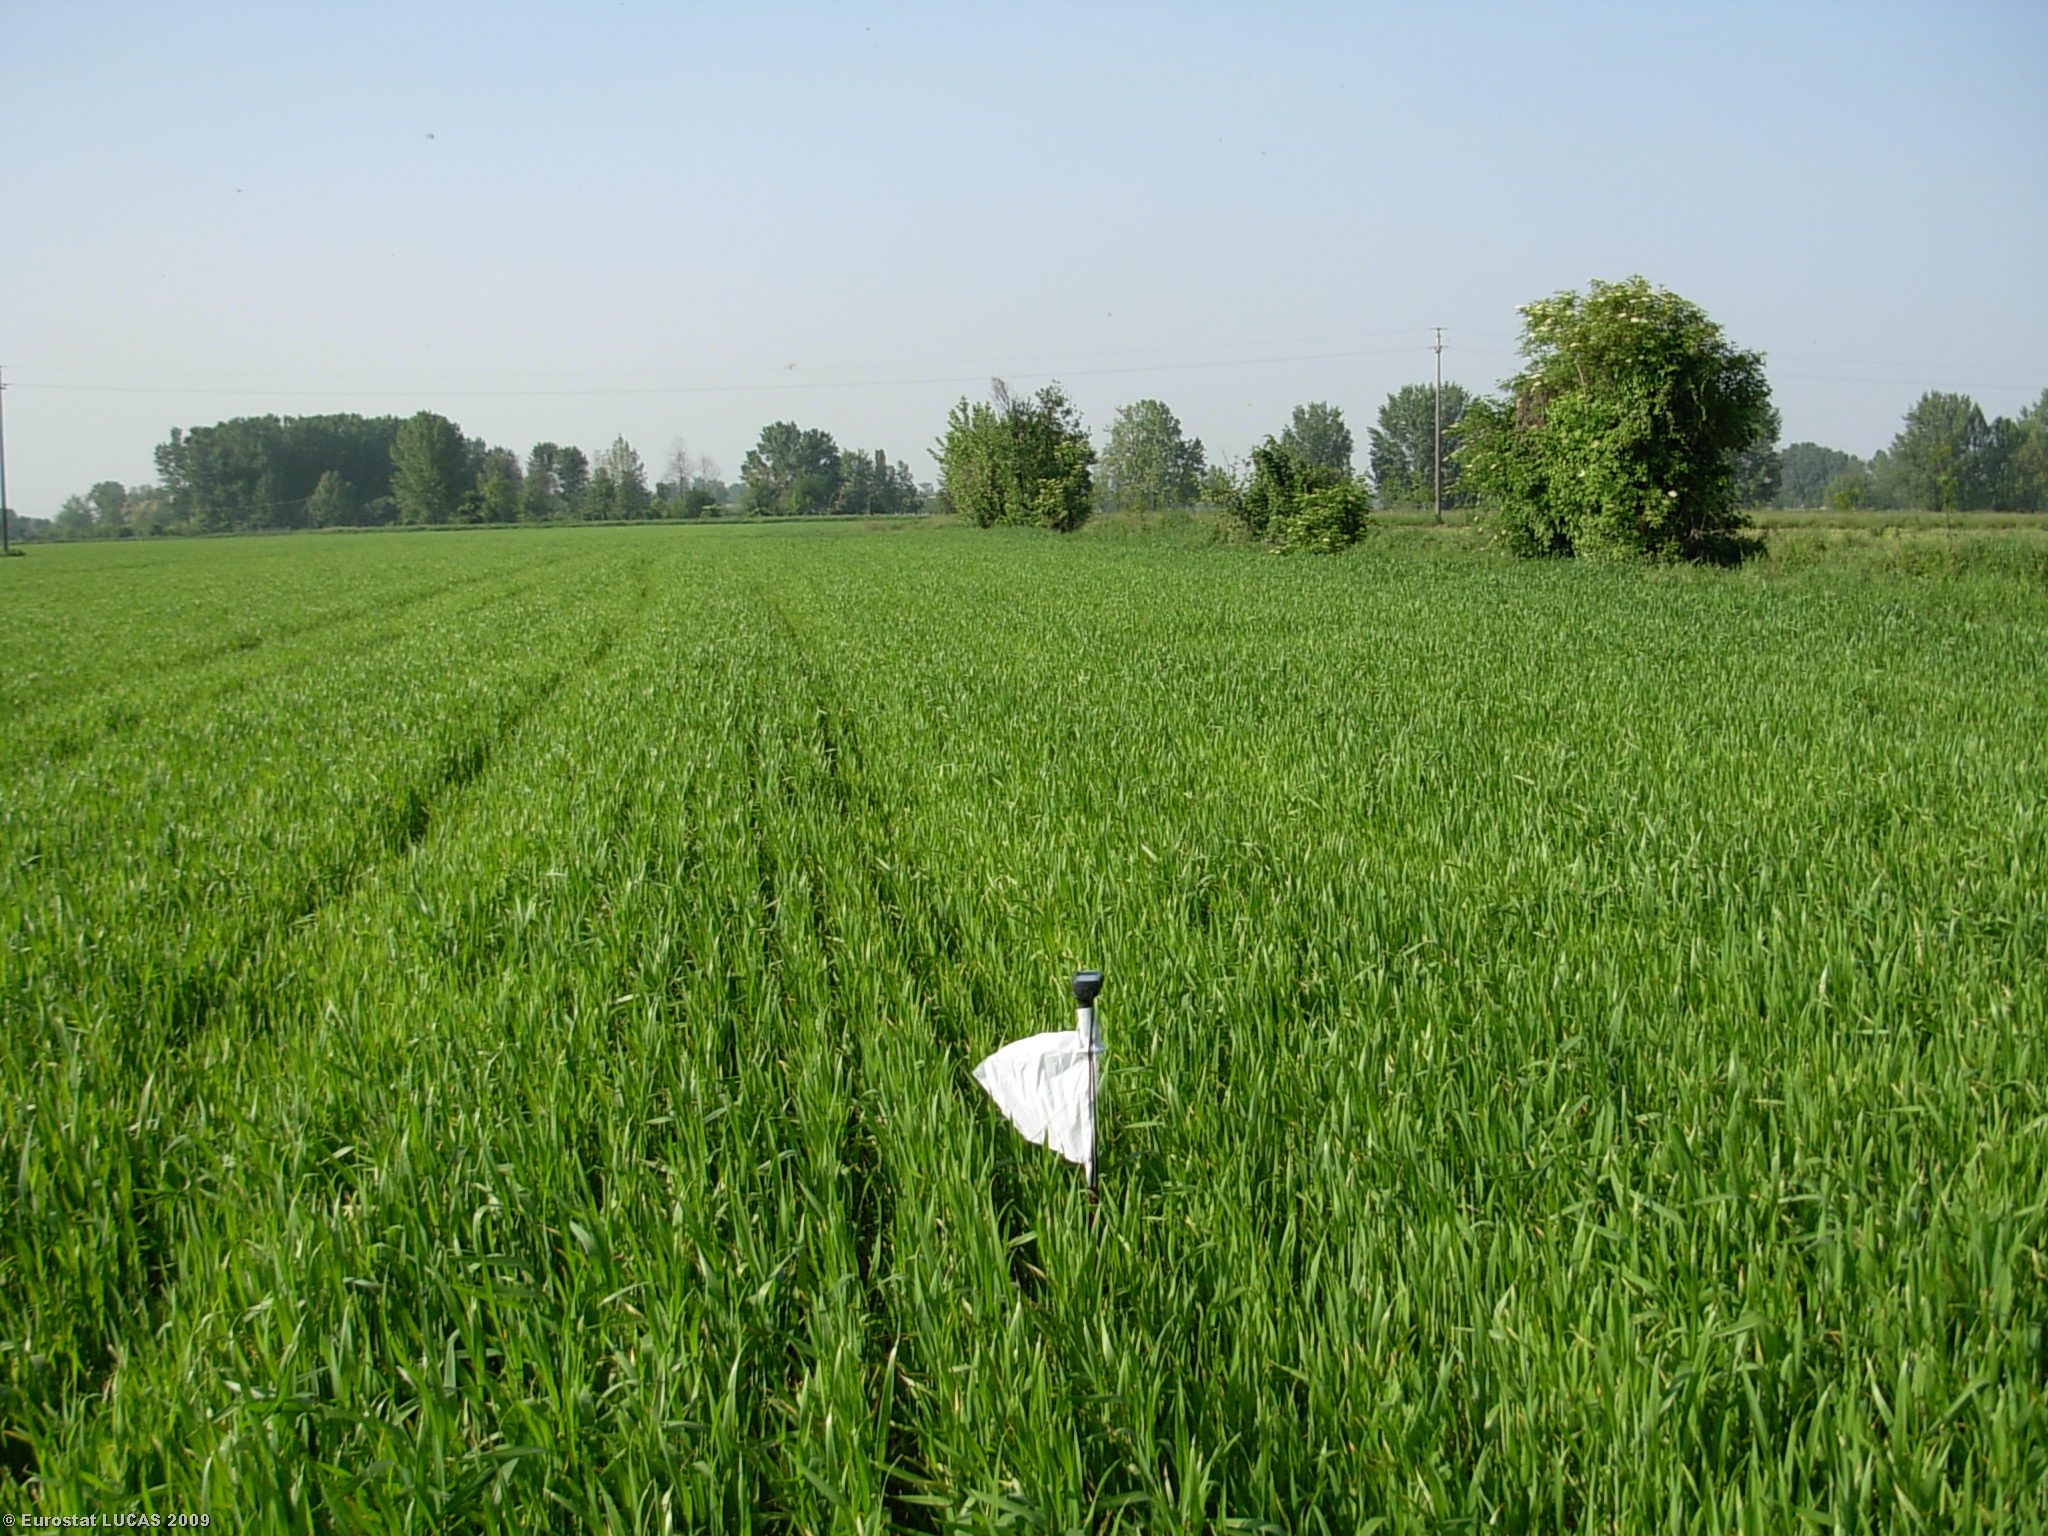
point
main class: Cropland
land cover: Common wheat
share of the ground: > 75 %
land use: Agriculture (excluding fallow land and kitchen gardens)
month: May
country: IT
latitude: 45.2698
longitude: 10.2672
